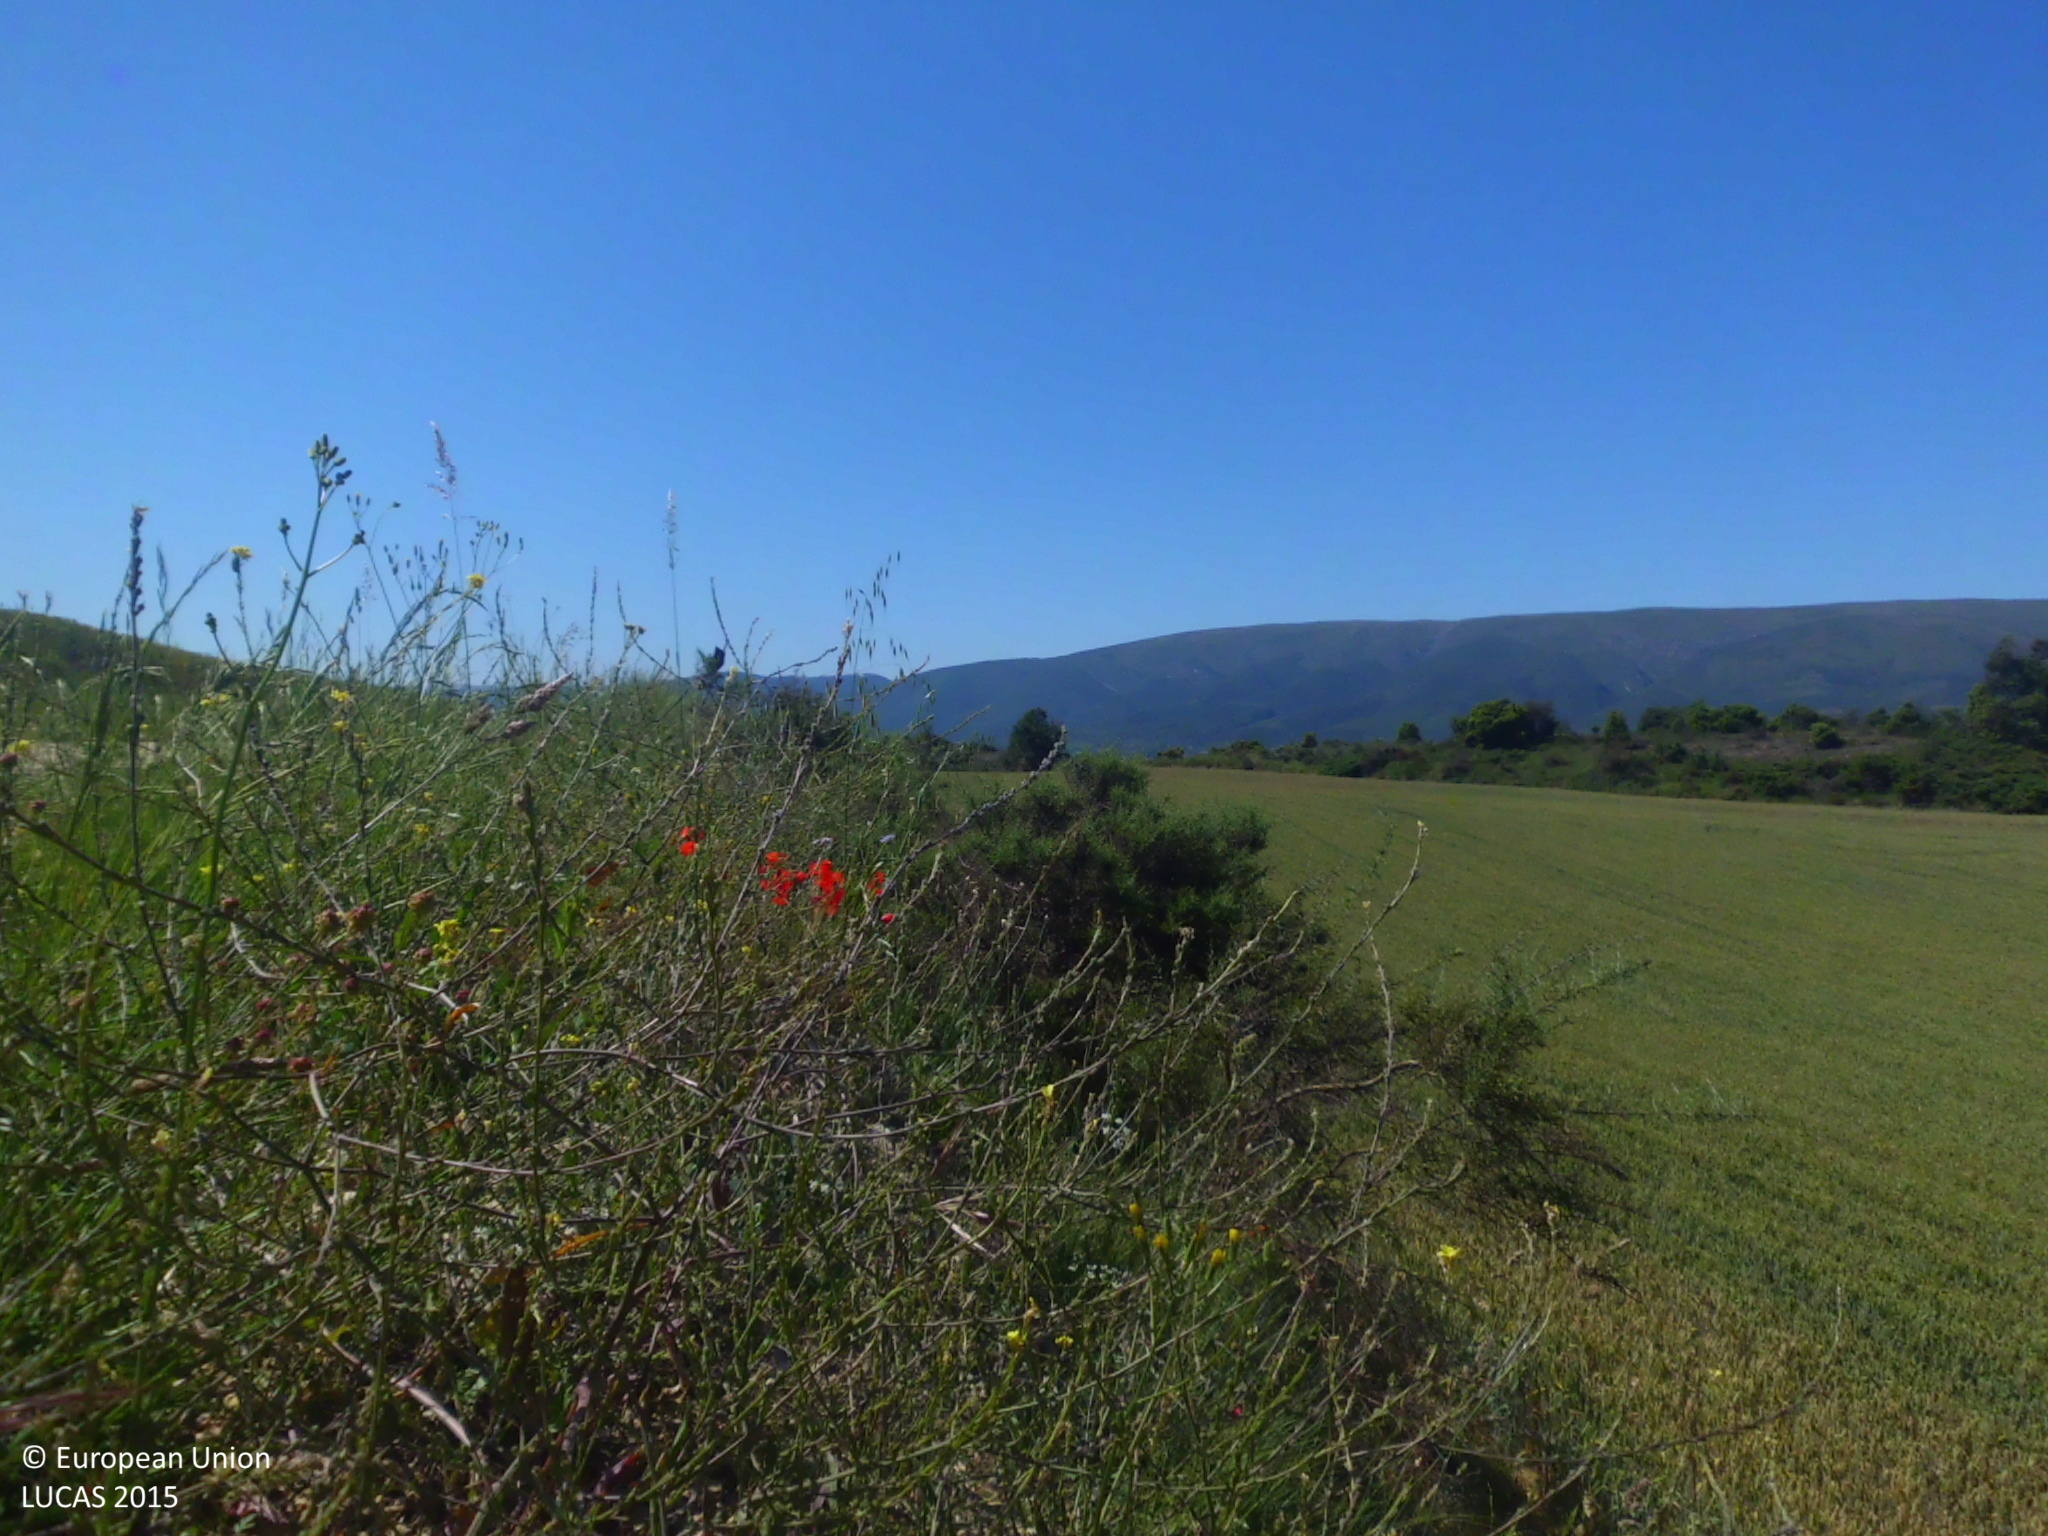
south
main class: Shrubland
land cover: Shrubland without tree cover
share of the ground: > 75 %
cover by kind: shrubs 90 %, herbaceous plants 10 %
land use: Abandoned areas
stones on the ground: > 50 %
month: June
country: ES
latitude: 42.8718
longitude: -3.4171
